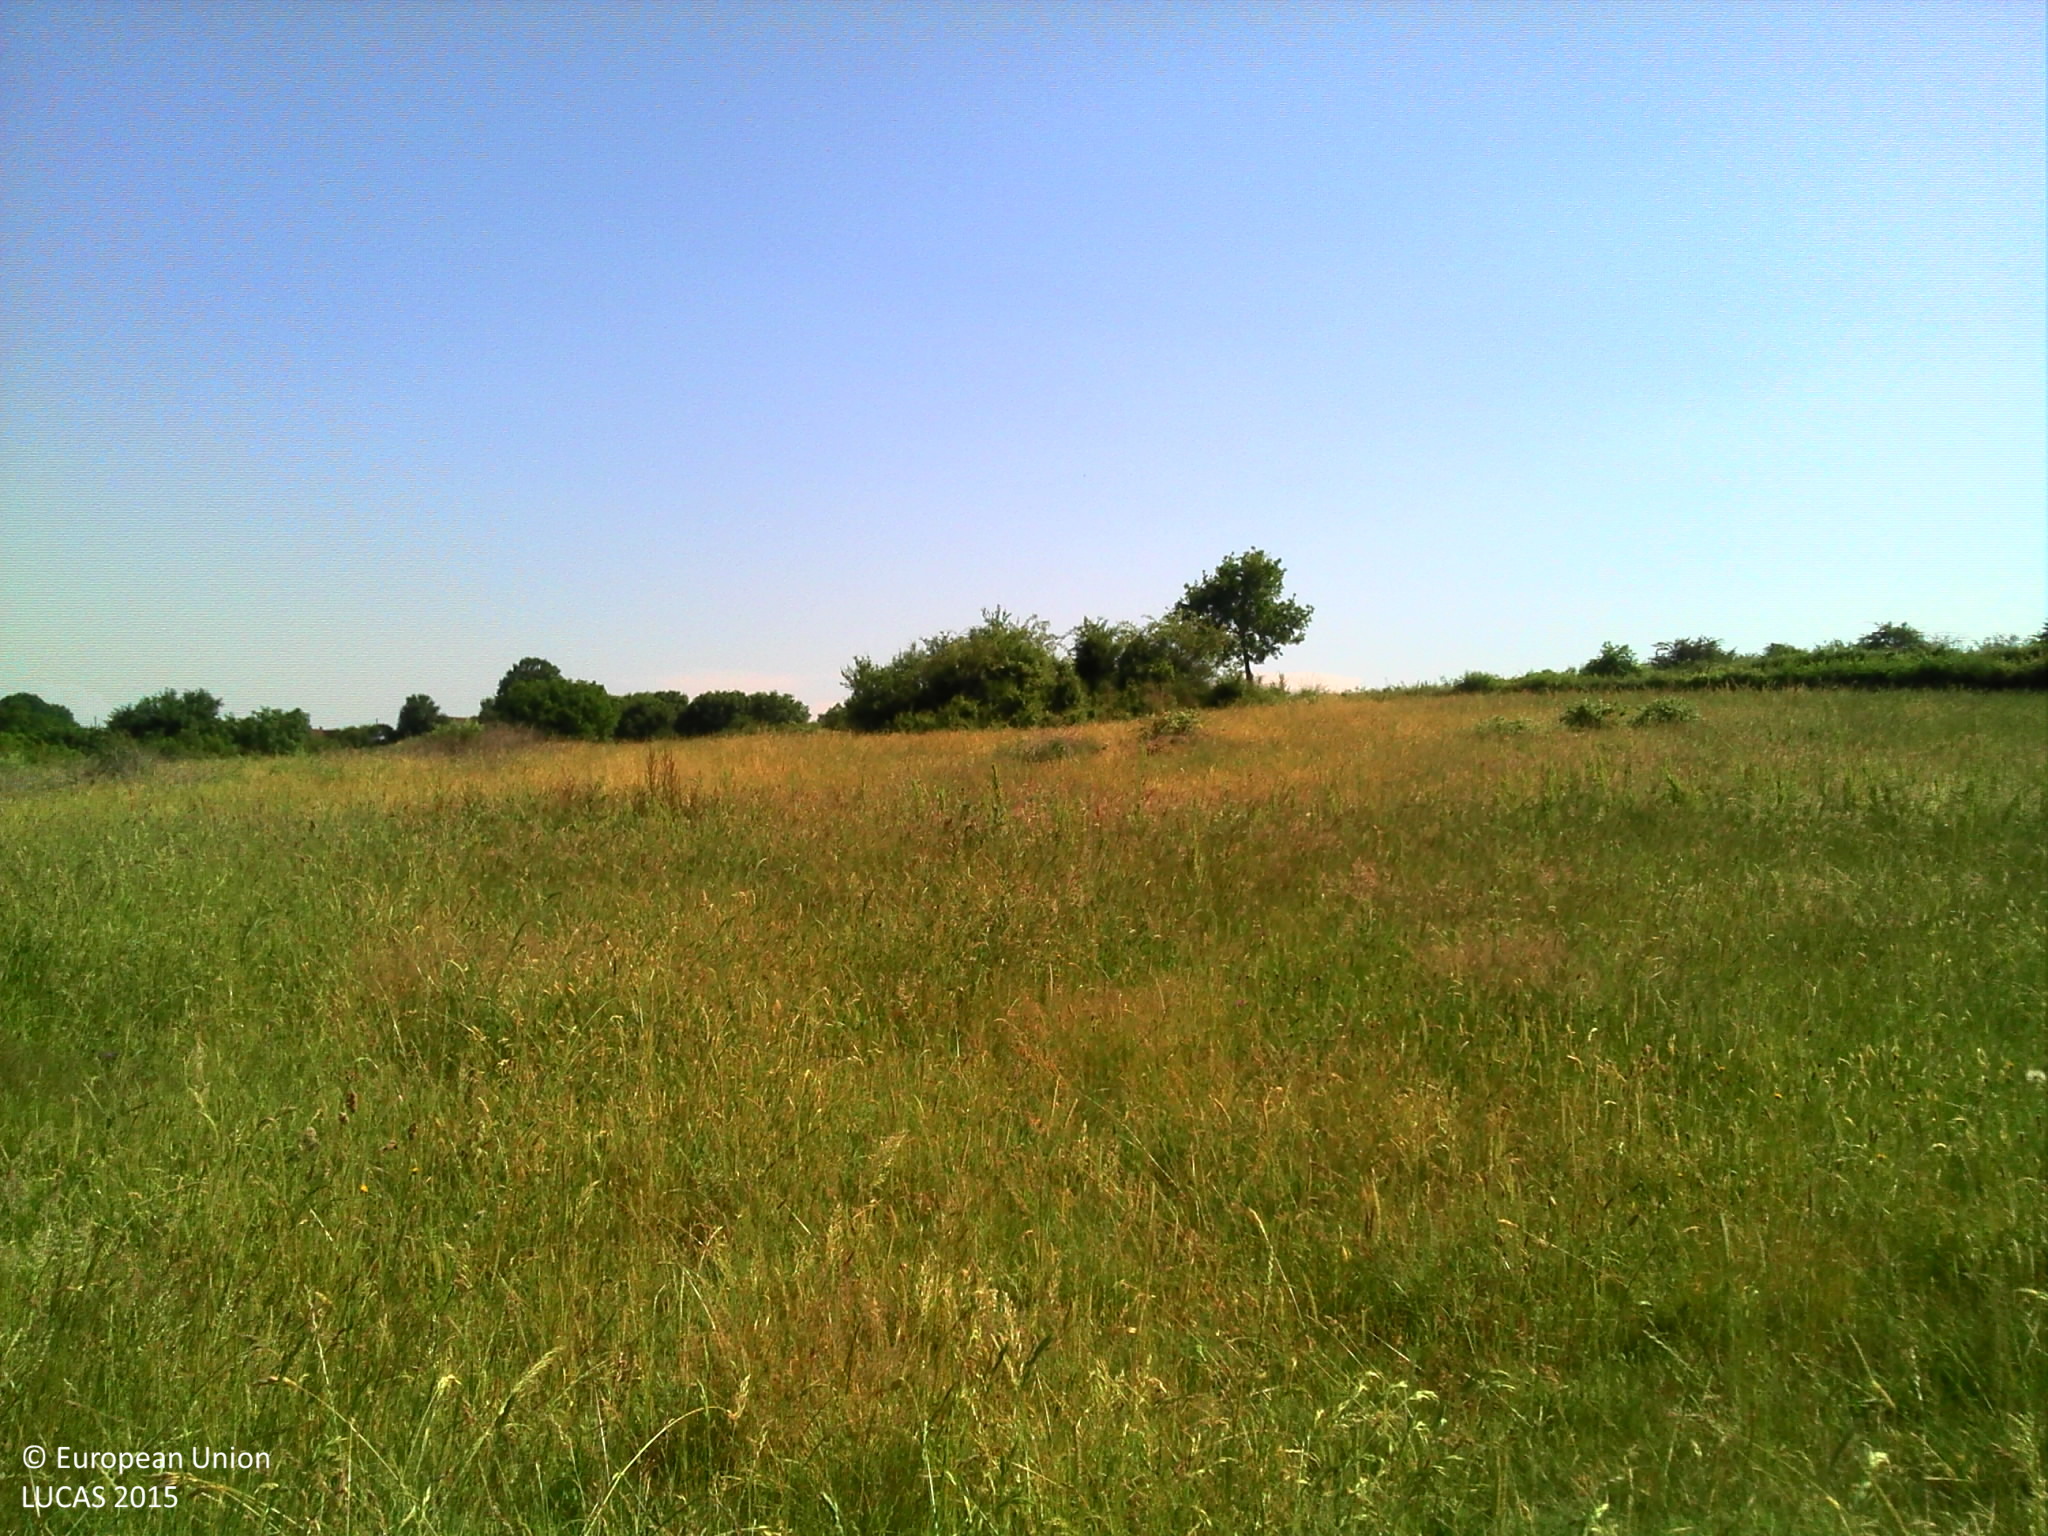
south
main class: Grassland
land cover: Grassland without tree/shrub cover
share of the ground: > 75 %
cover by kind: herbaceous plants 100 %
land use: Agriculture (excluding fallow land and kitchen gardens)
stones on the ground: < 10 %
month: June
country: FR
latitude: 46.4465
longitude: 2.7194
